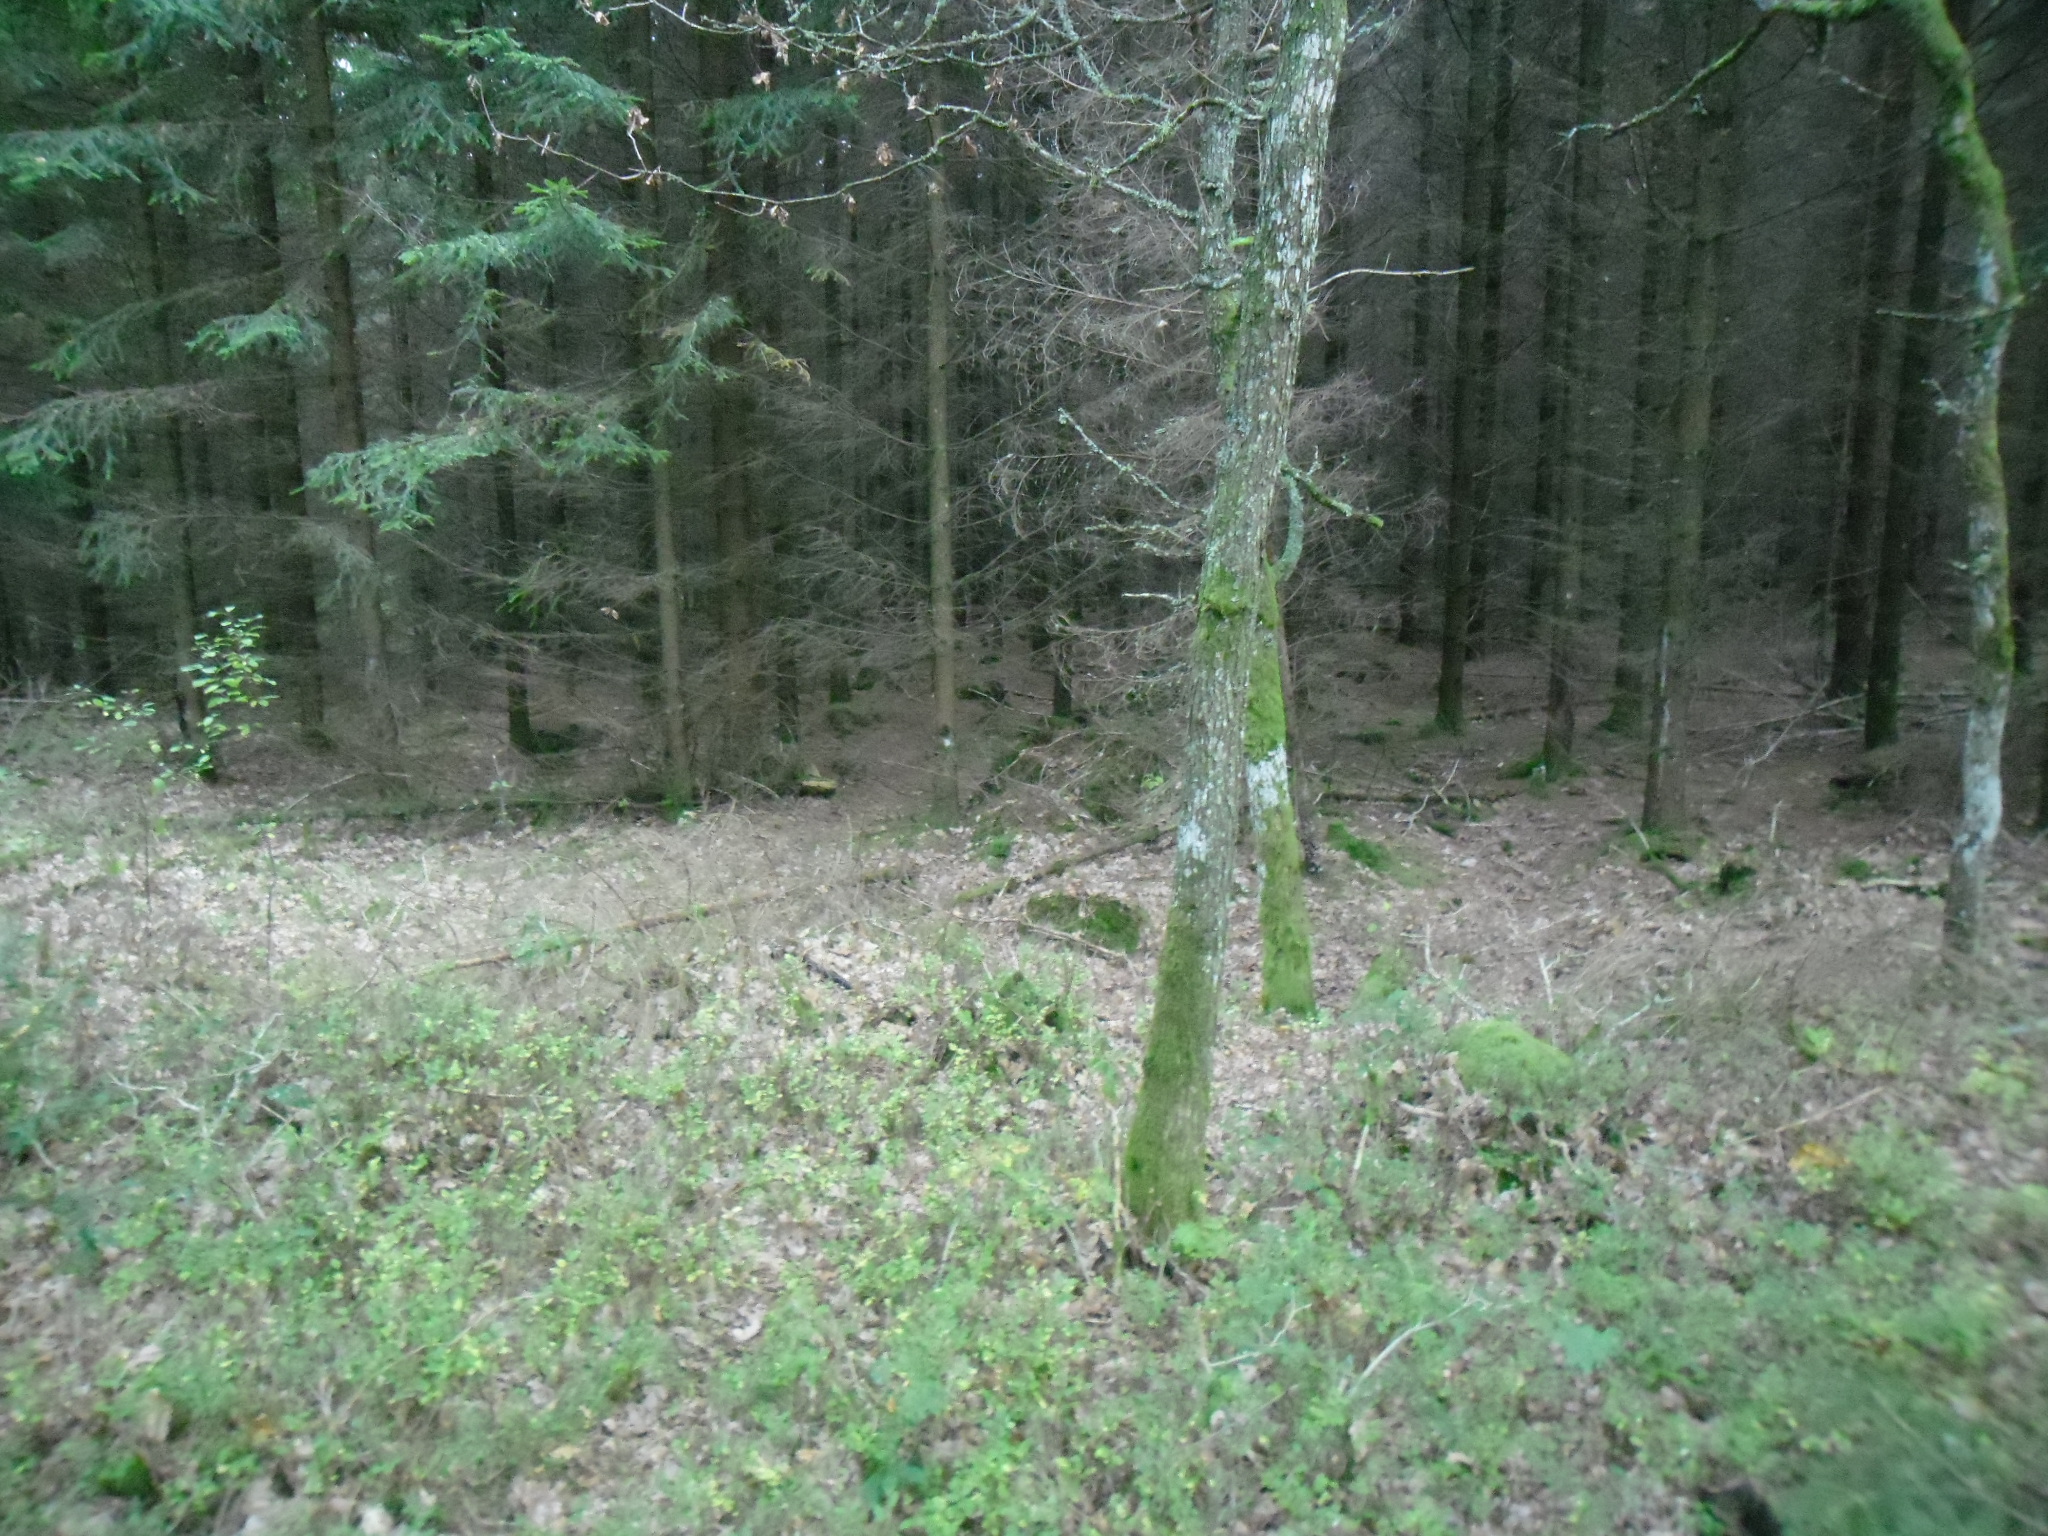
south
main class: Woodland
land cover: Broadleaved woodland
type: acidophilous oak and oak-birch forest
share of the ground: > 75 %
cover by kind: broadleaved forest trees 100 %
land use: Forestry
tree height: > 5 m
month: October
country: SE
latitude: 56.6171
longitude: 13.1419
